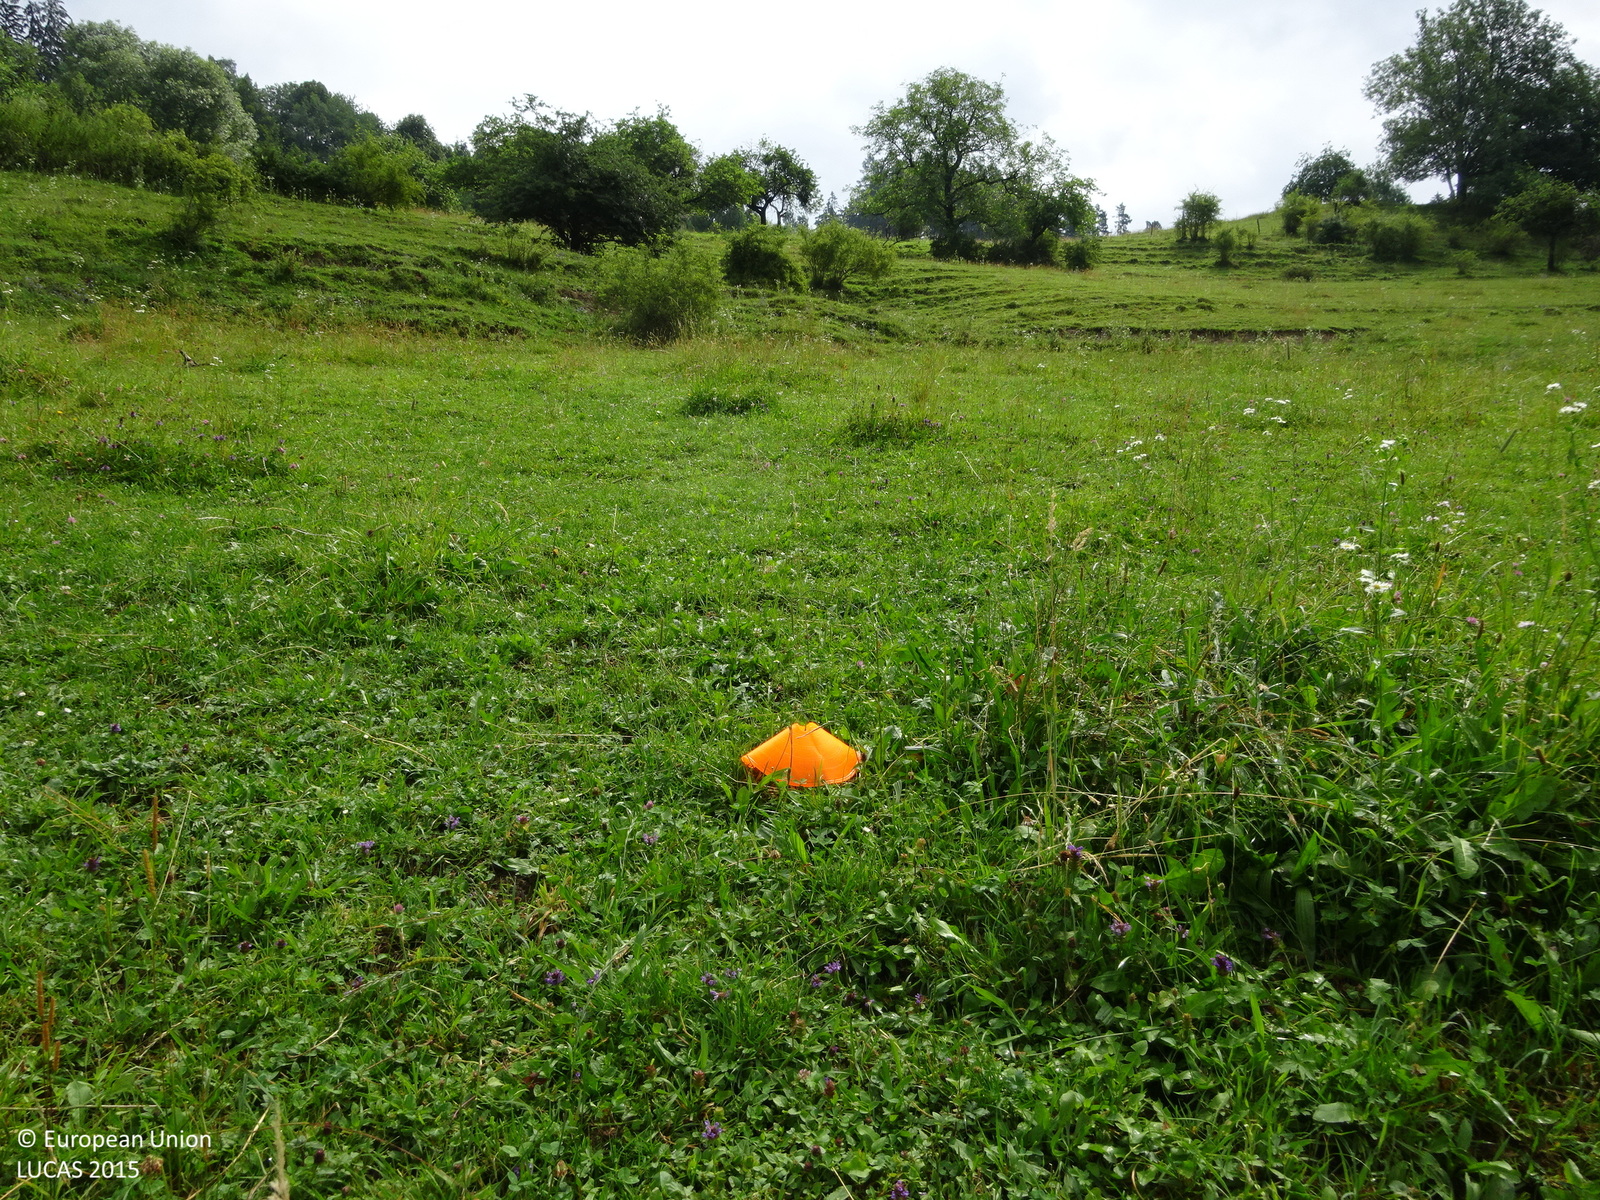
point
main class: Grassland
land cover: Grassland without tree/shrub cover
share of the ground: > 75 %
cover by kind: herbaceous plants 100 %
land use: Agriculture (excluding fallow land and kitchen gardens)
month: July
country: AT
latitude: 47.1304
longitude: 15.1277
